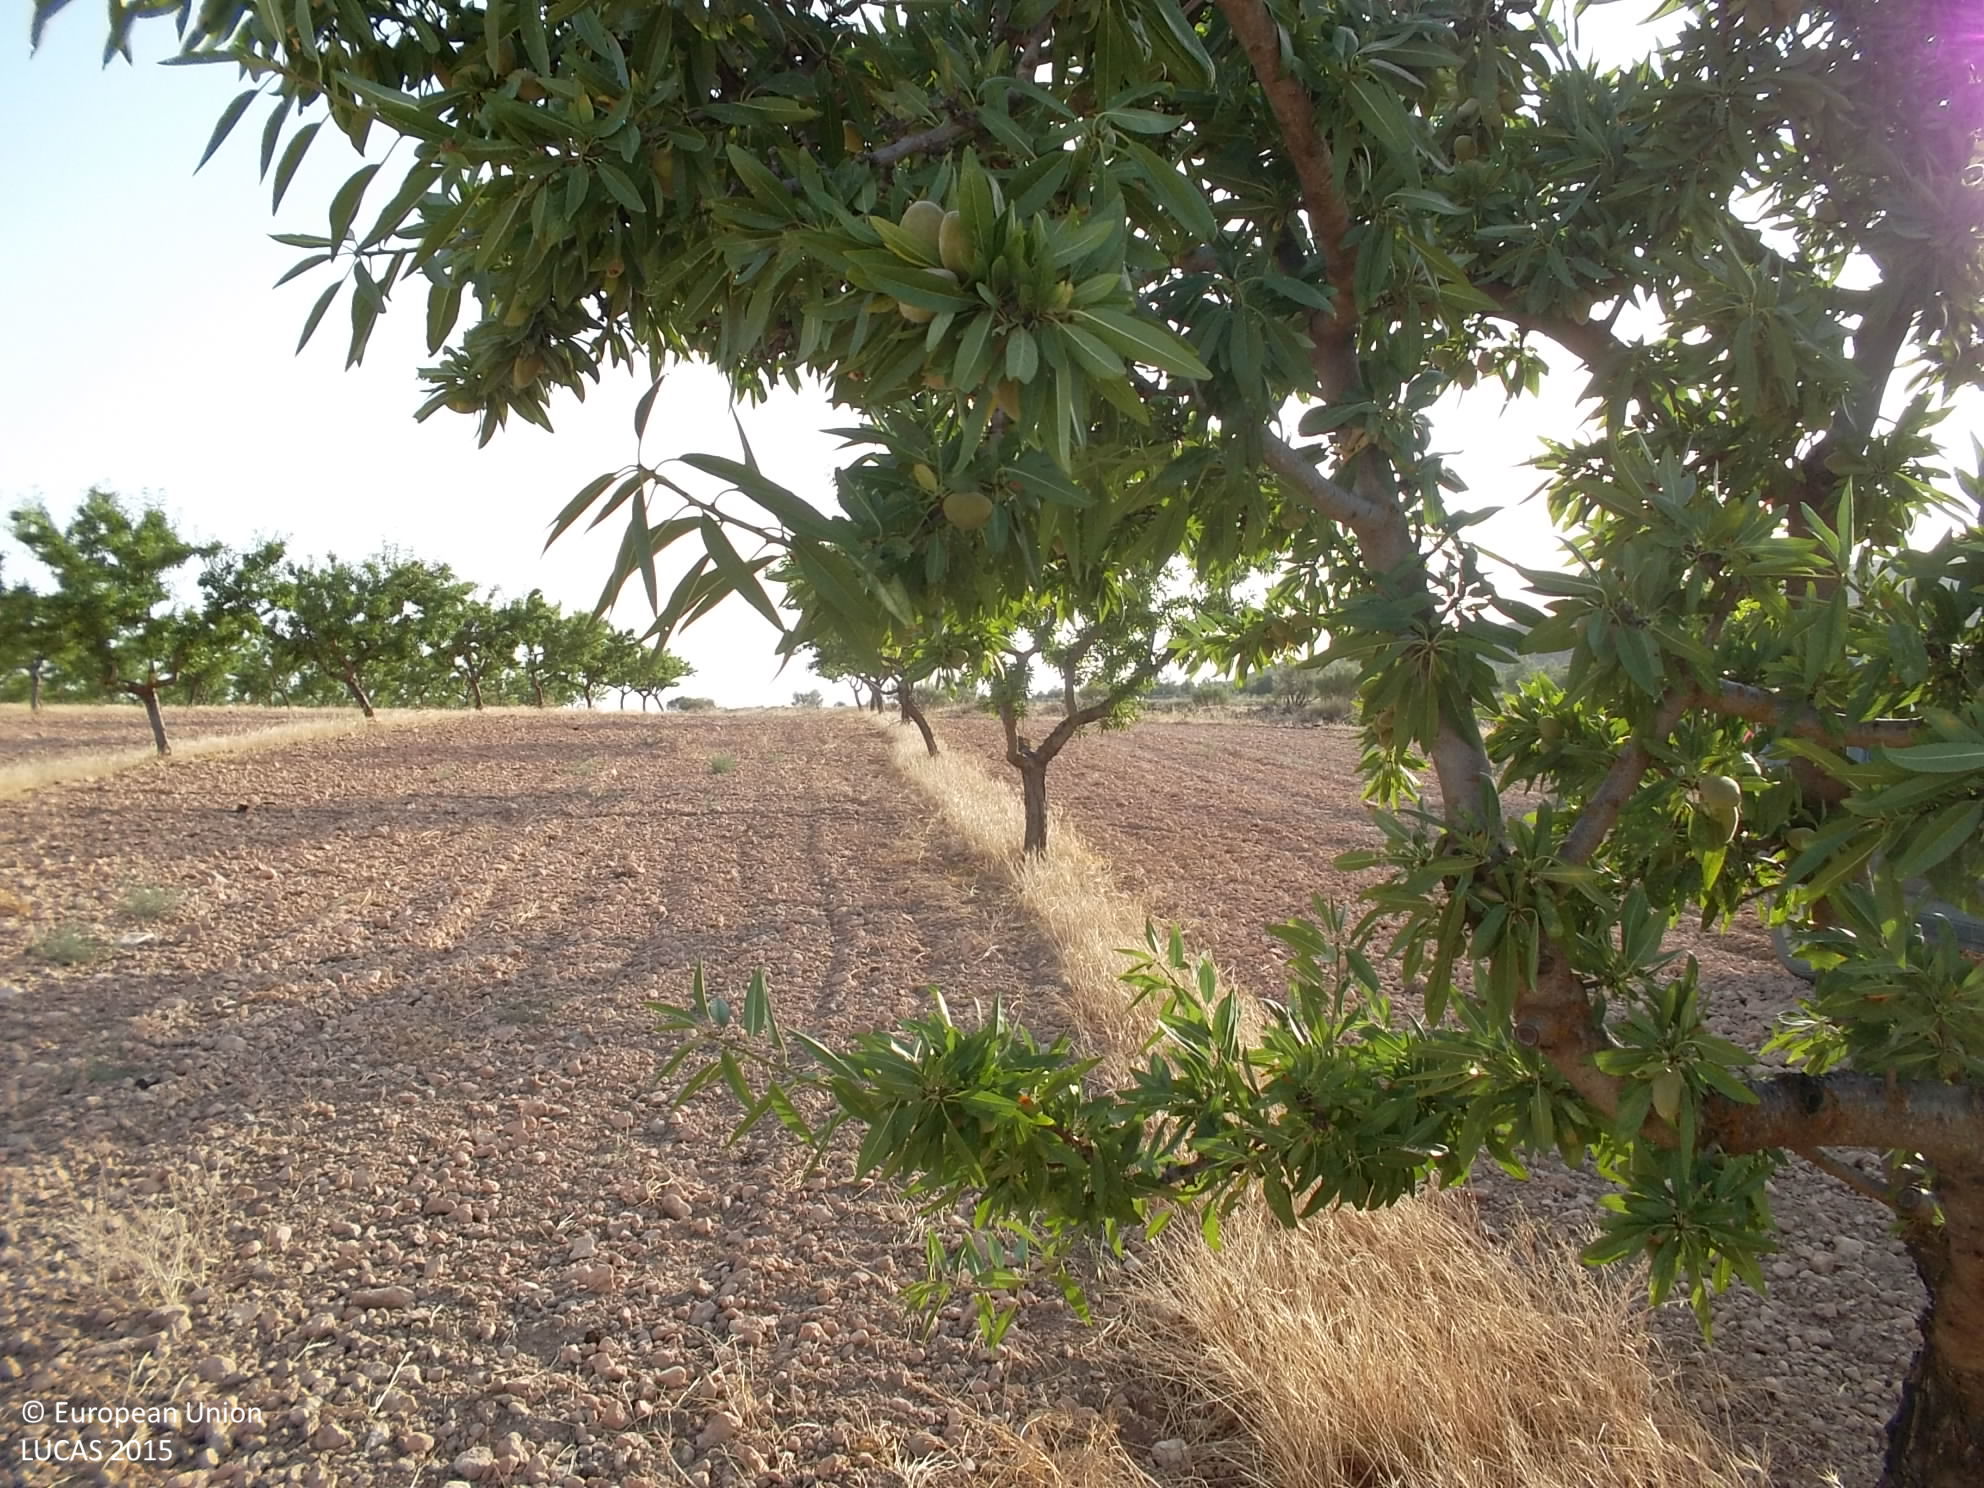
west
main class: Cropland
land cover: Nuts trees
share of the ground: 25 - 50 %
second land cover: Other bare soil
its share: > 75 %
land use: Agriculture (excluding fallow land and kitchen gardens)
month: July
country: ES
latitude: 37.8206
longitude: -2.4745
